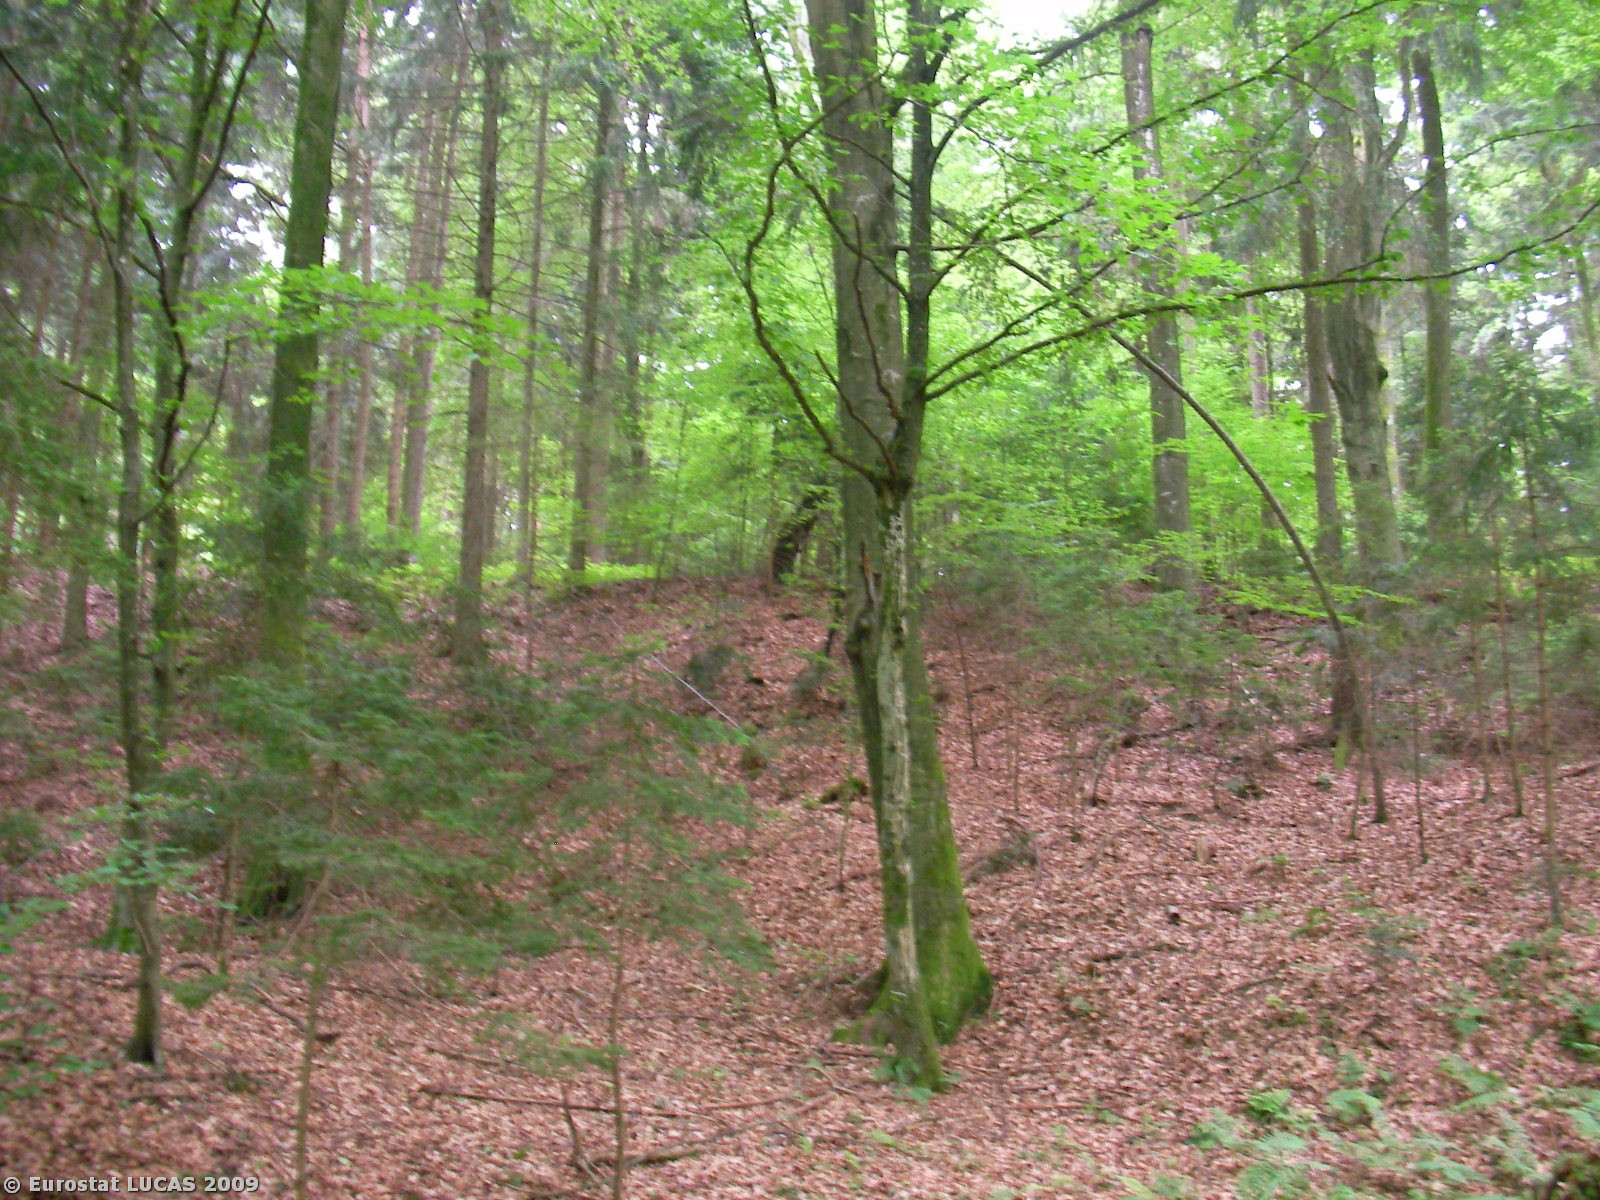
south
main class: Woodland
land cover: Mixed woodland
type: hemiboreal forest and nemoral coniferous forest and mixed broadleaved-coniferous forest
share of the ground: > 75 %
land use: Forestry
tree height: > 5 m
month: June
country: AT
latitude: 47.0642
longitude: 15.7281
